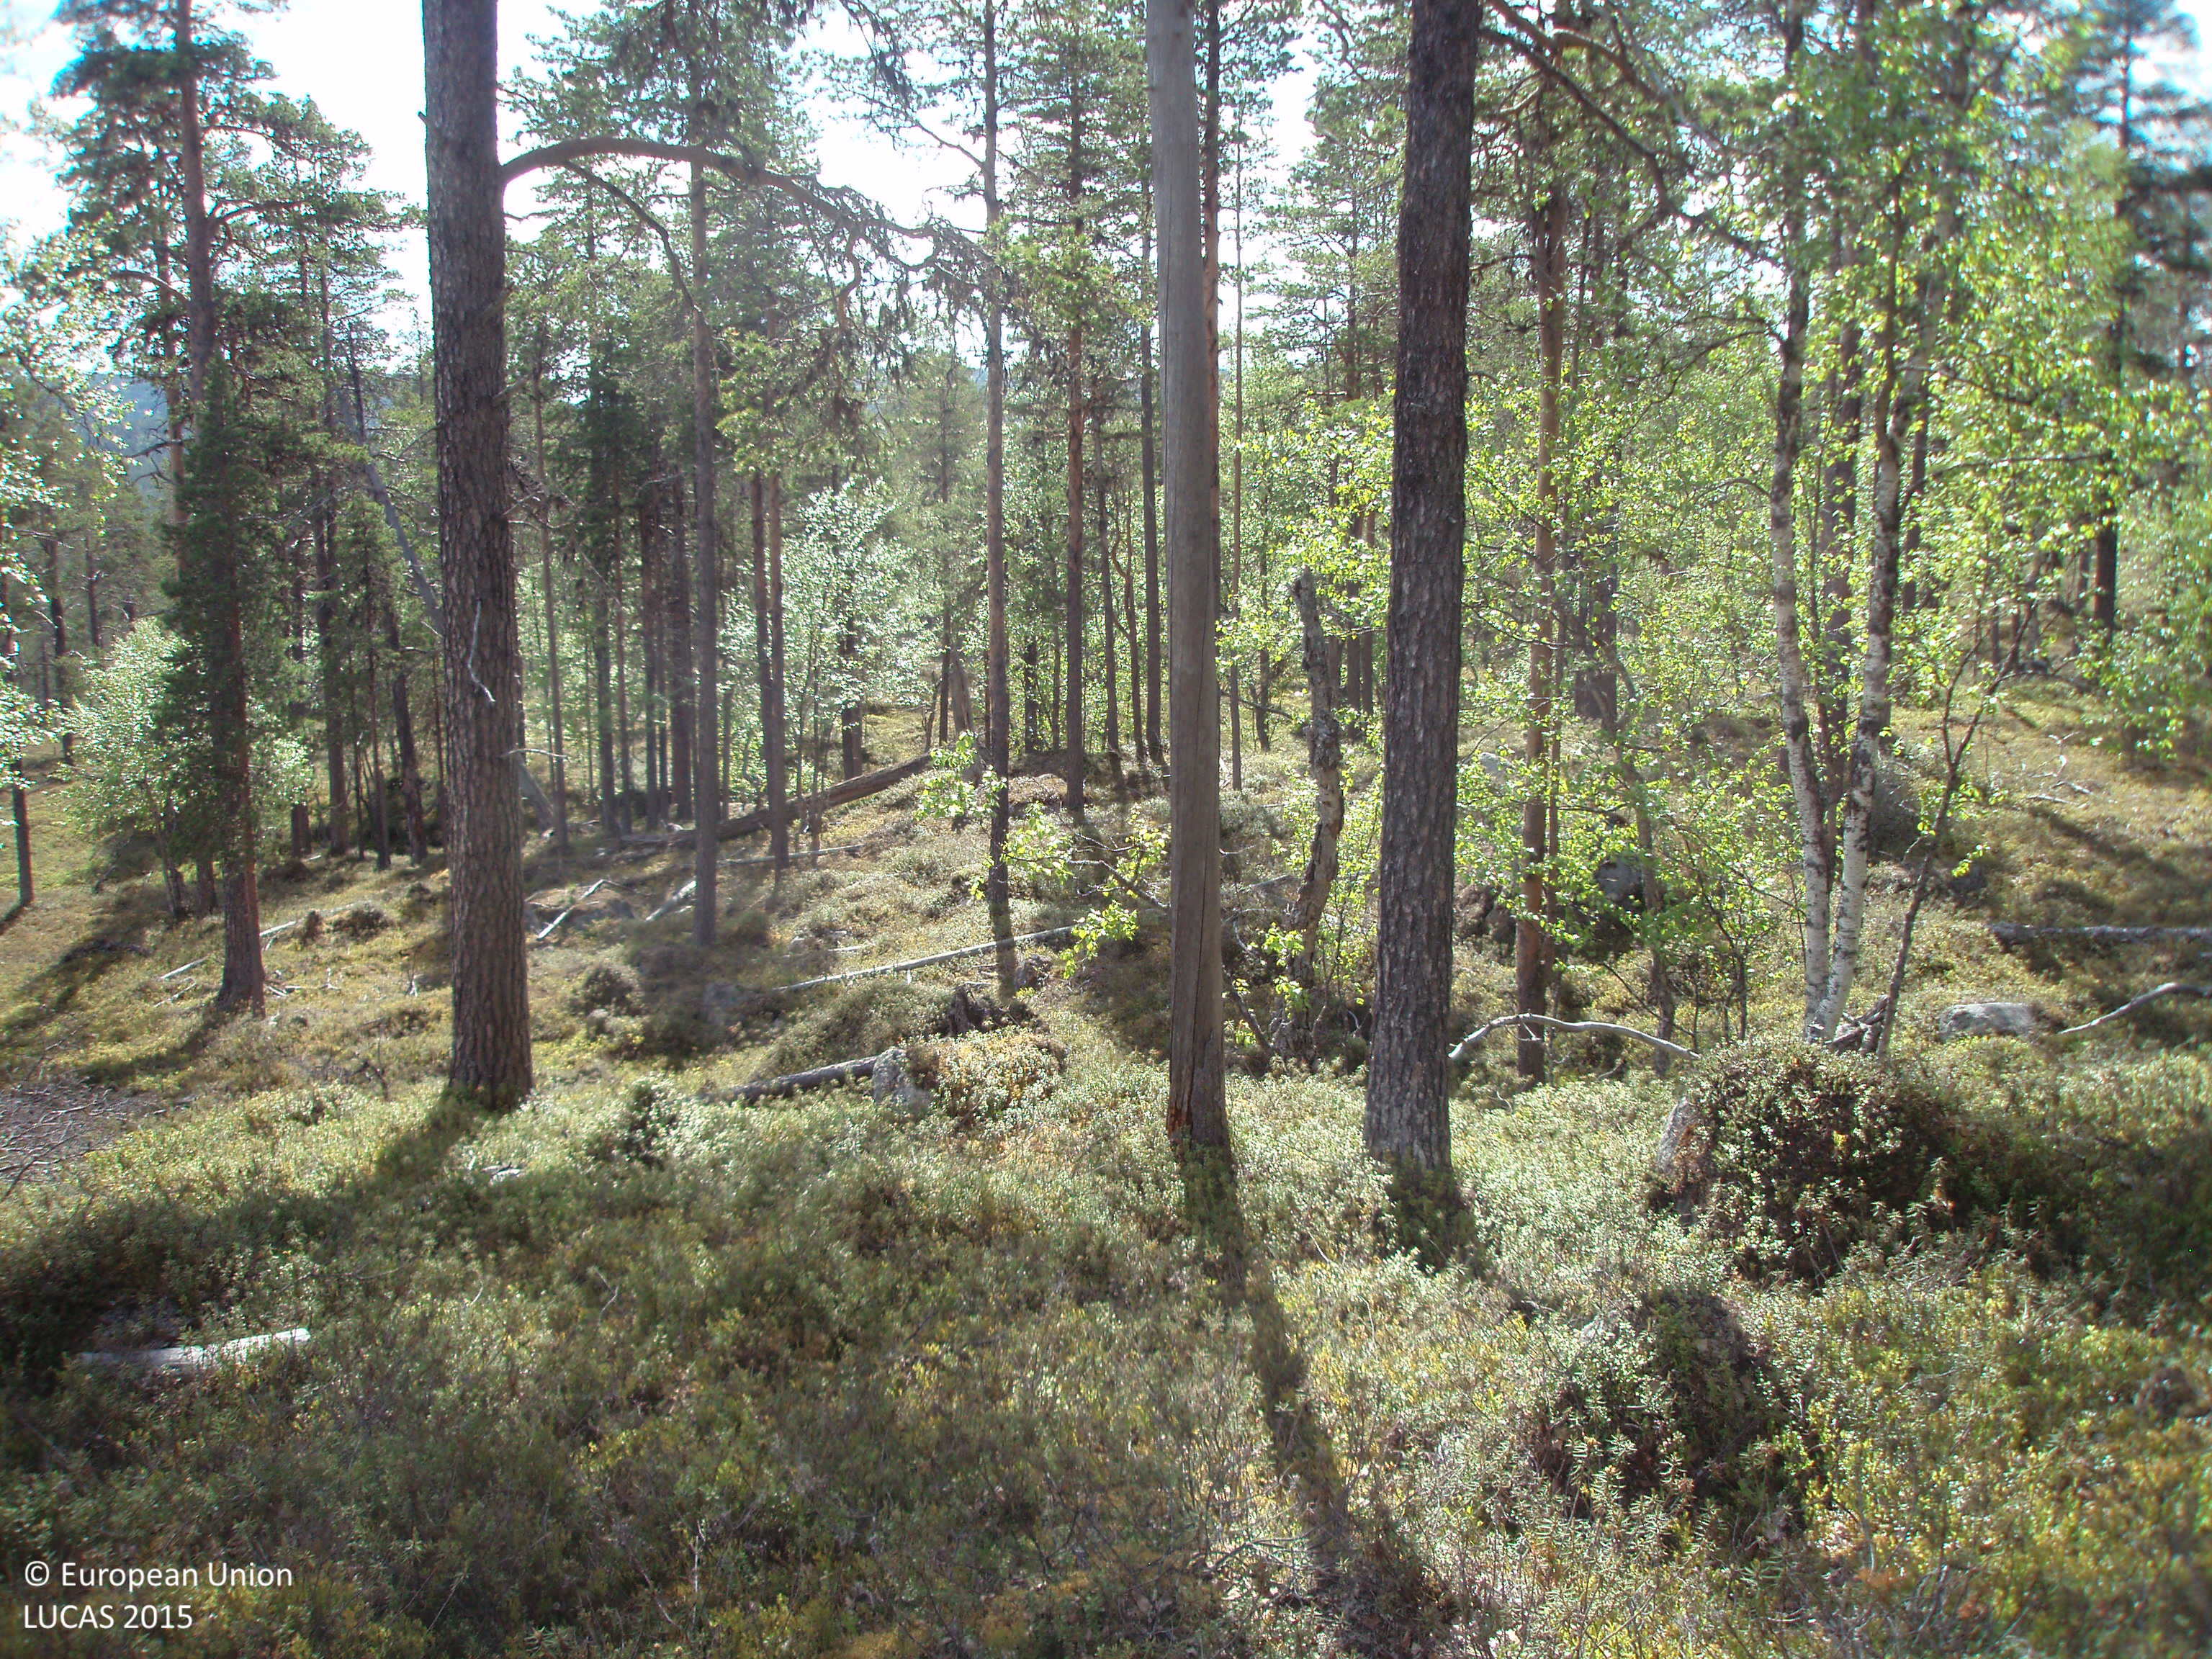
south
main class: Woodland
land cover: Pine dominated mixed woodland
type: boreal forest
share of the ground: 50 - 75 %
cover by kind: coniferous forest trees 35 %, broadleaved forest trees 35 %, shrubs 30 %
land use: Forestry
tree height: > 5 m
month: June
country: FI
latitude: 68.7486
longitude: 28.1151
